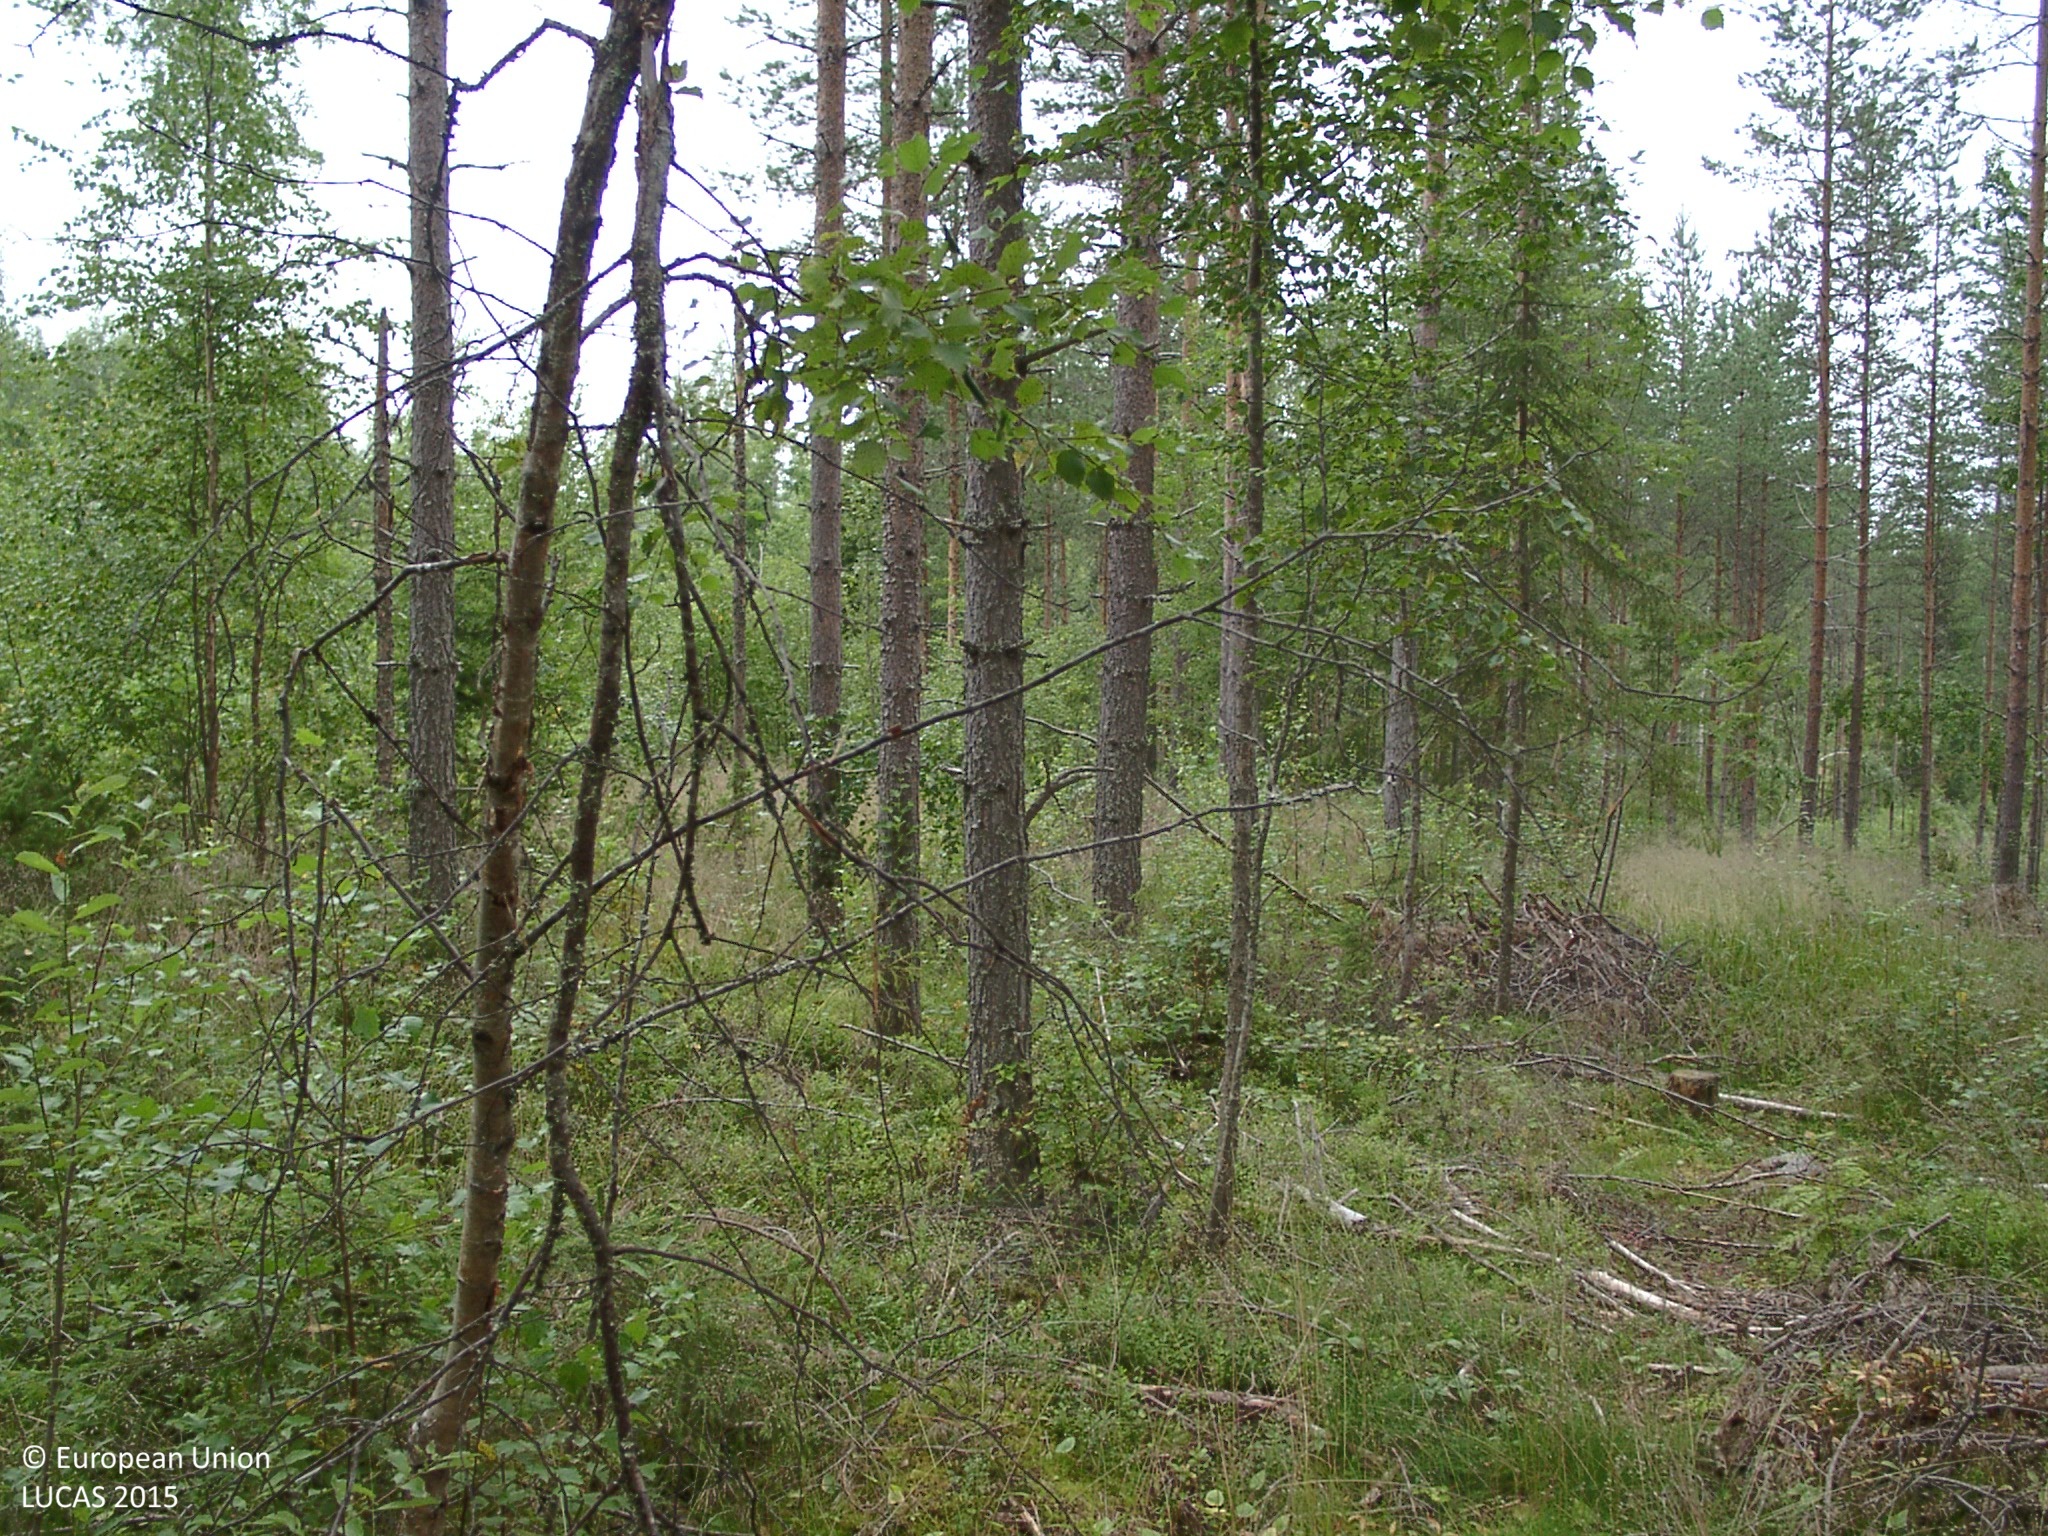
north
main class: Woodland
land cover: Pine dominated mixed woodland
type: boreal forest
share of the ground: 50 - 75 %
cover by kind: coniferous forest trees 45 %, broadleaved forest trees 20 %, shrubs 15 %, herbaceous plants 10 %, lichens and mosses 5 %
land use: Forestry
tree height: > 5 m
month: August
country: FI
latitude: 62.8553
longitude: 24.5672
